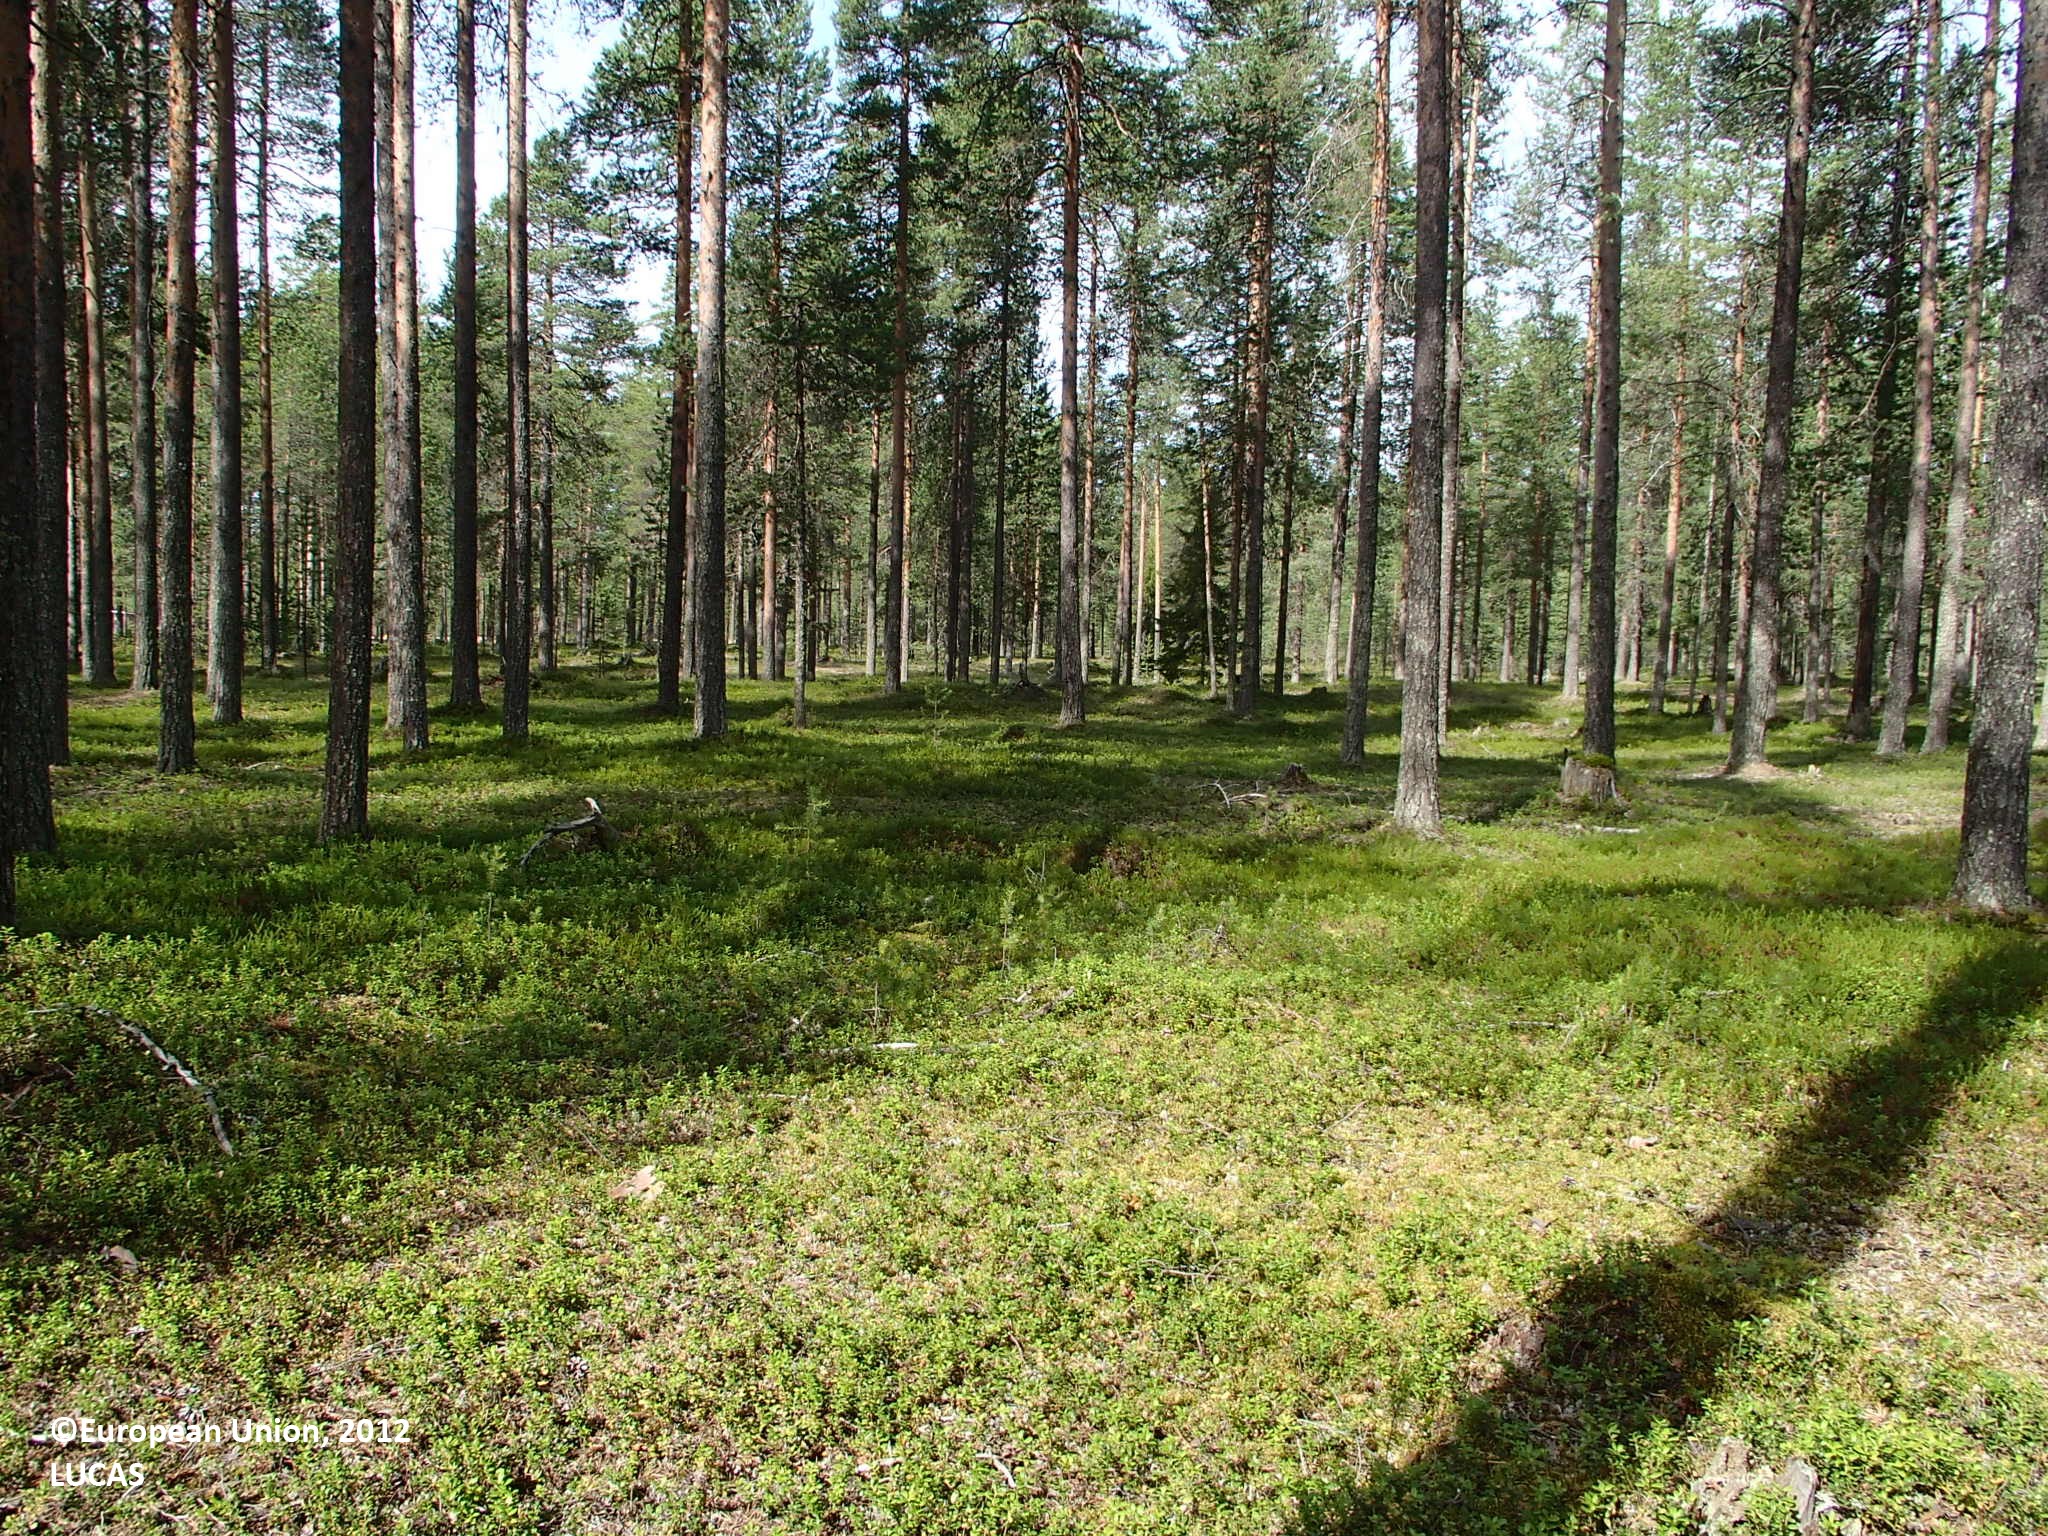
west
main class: Woodland
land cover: Pine dominated coniferous woodland
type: boreal forest
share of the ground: > 75 %
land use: Forestry
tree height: > 5 m
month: July
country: FI
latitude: 66.4071
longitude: 25.4922
